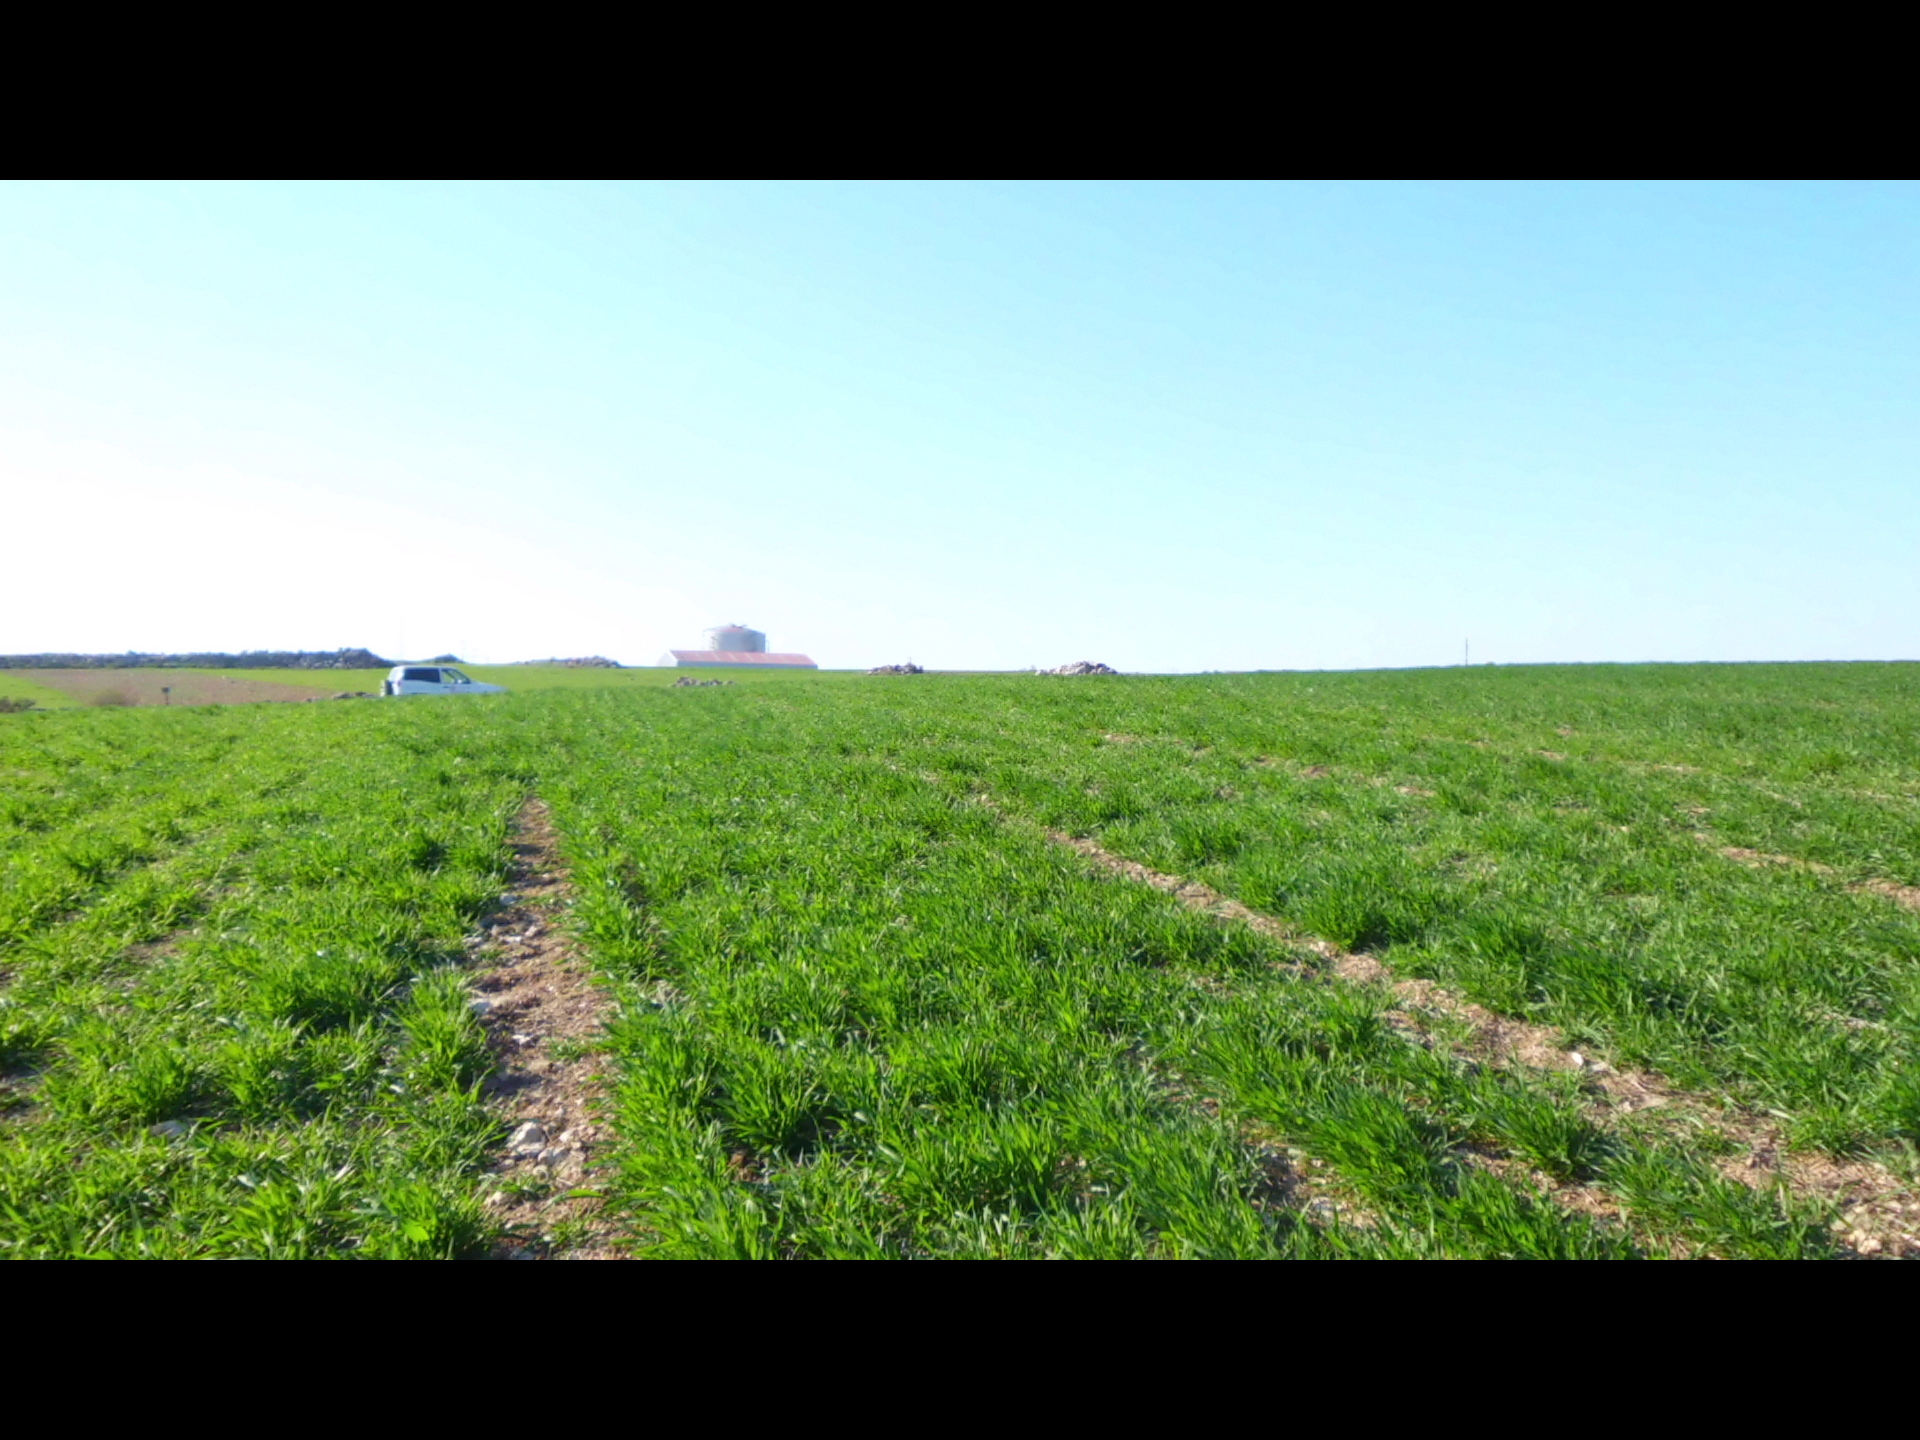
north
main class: Cropland
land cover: Barley
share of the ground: > 75 %
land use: Agriculture (excluding fallow land and kitchen gardens)
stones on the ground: < 10 %
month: April
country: ES
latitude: 42.3091
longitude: -3.6592
